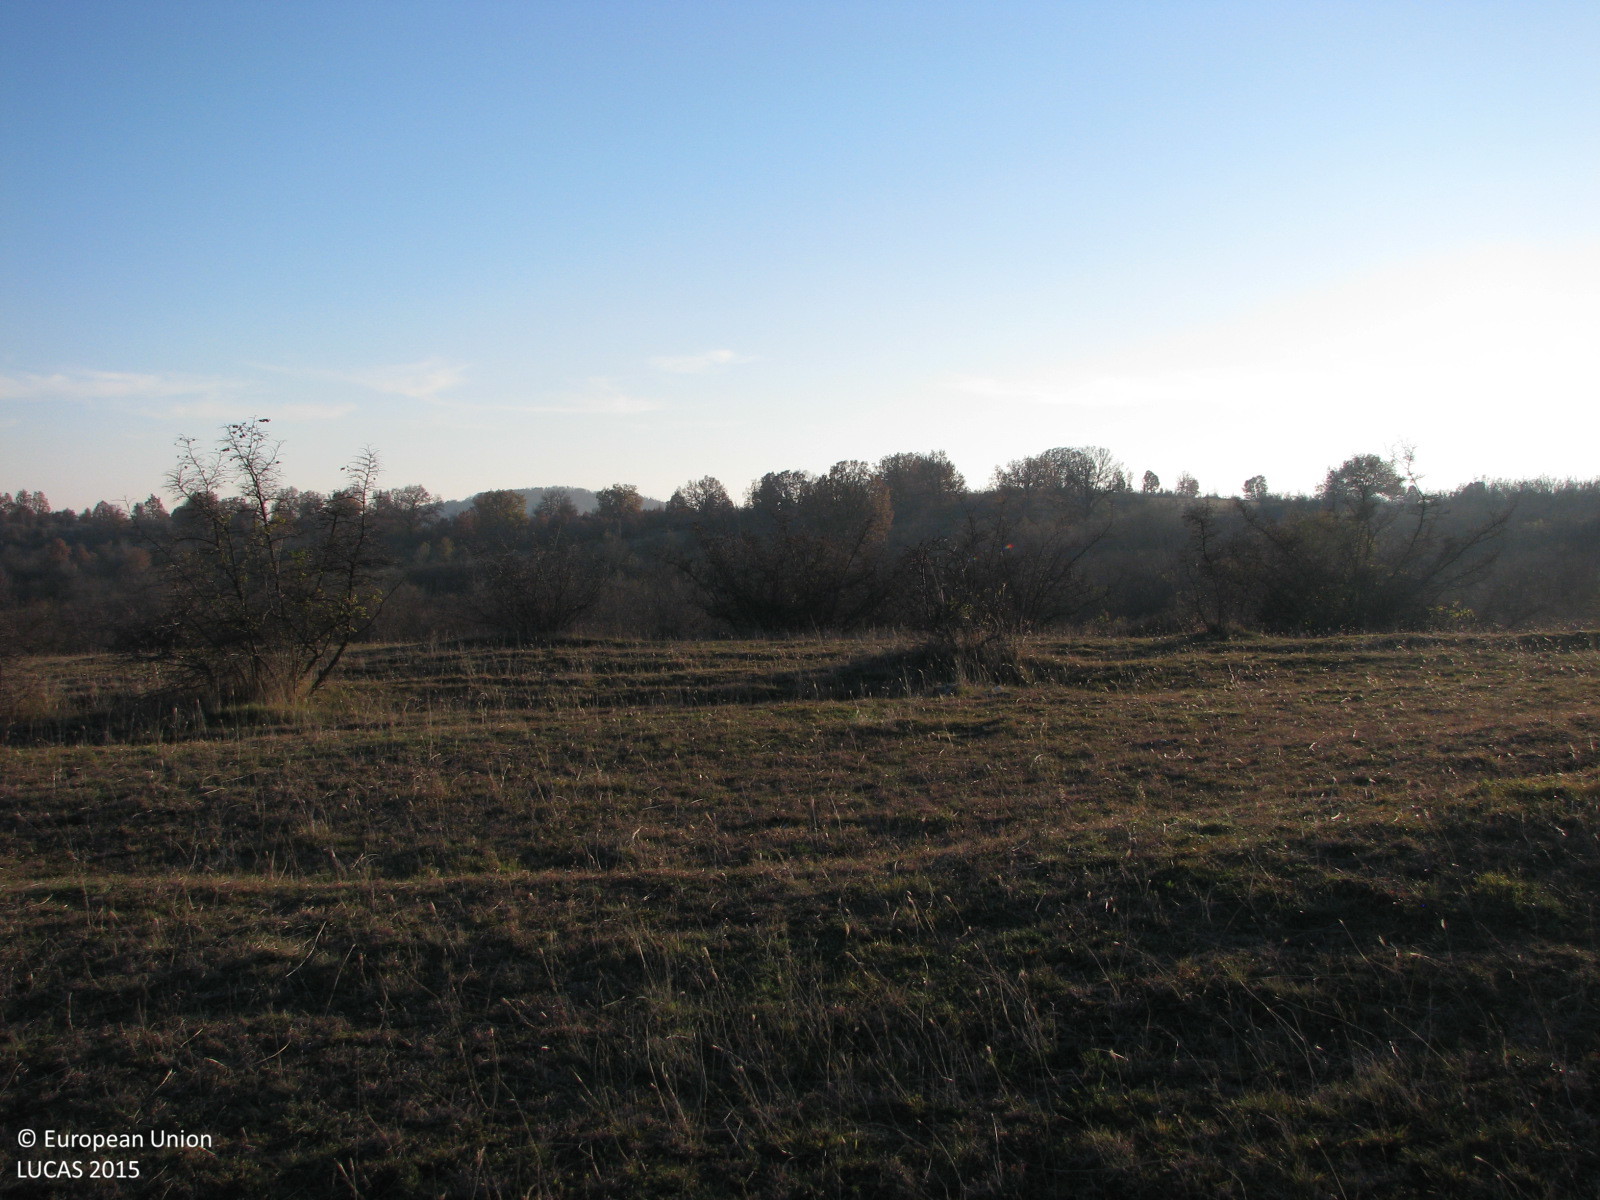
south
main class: Grassland
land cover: Grassland with sparse tree/shrub cover
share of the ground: > 75 %
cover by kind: herbaceous plants 70 %, lichens and mosses 20 %, broadleaved forest trees 5 %, shrubs 5 %
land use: Agriculture (excluding fallow land and kitchen gardens)
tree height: < 5 m
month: December
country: BG
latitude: 42.4001
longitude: 25.0646
